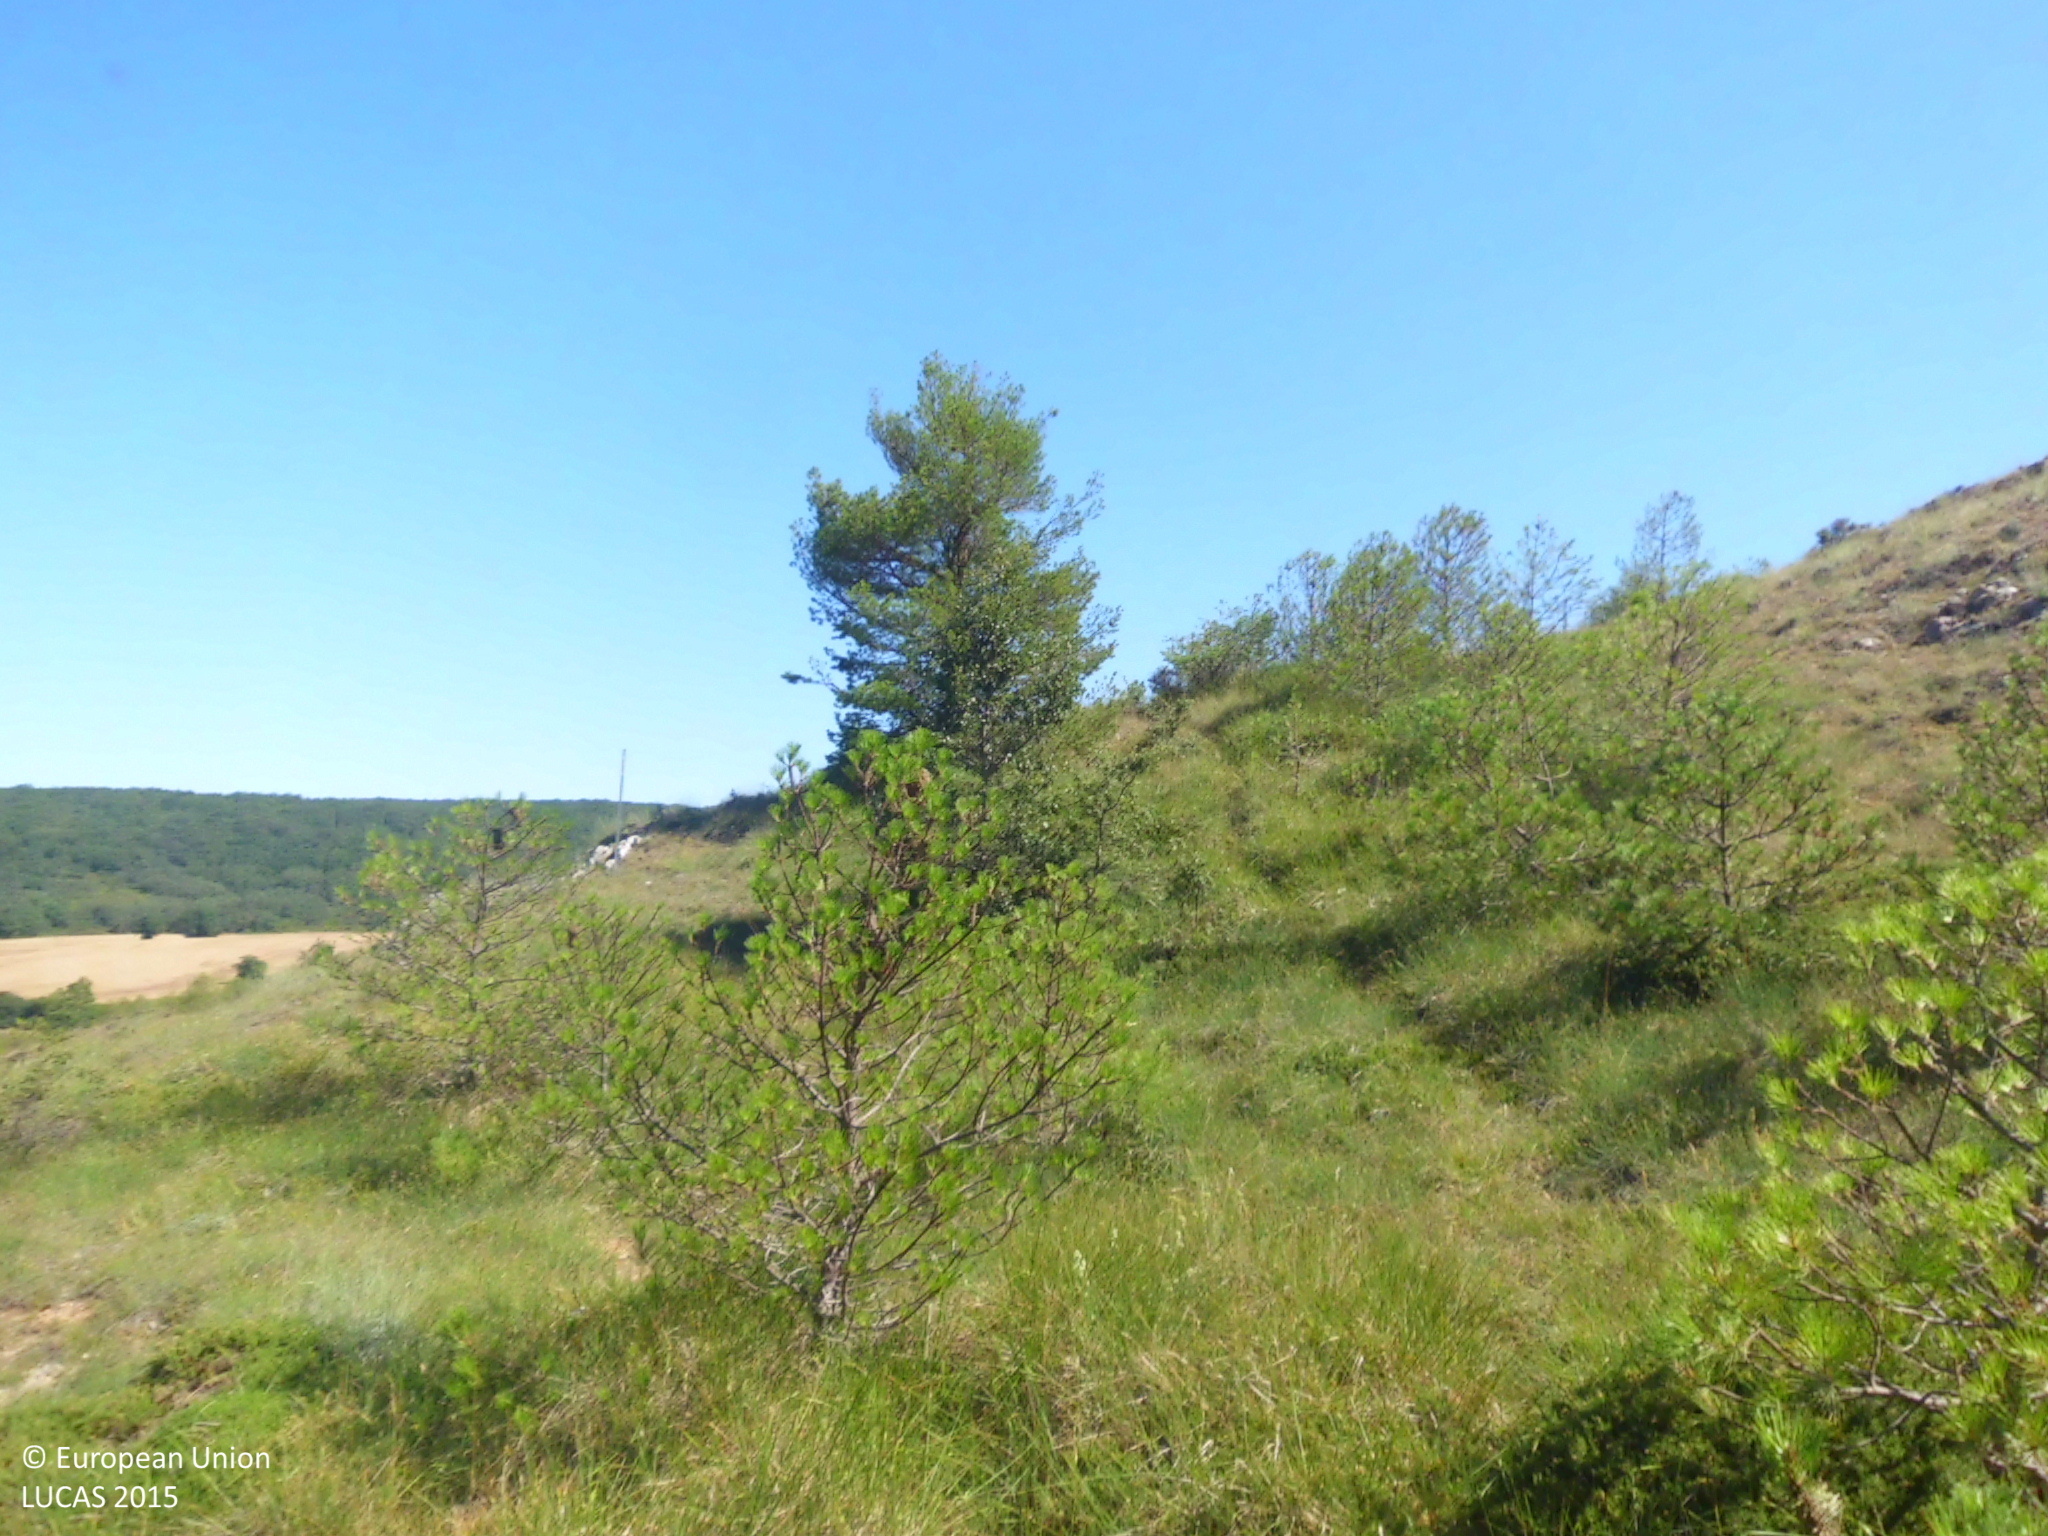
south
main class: Woodland
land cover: Pine dominated coniferous woodland
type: coniferous forest of the mediterranean region
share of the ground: 25 - 50 %
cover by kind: coniferous forest trees 40 %, shrubs 25 %, herbaceous plants 25 %, consolidated bare surface 10 %
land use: Forestry
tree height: < 5 m
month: July
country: ES
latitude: 42.7811
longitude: -4.3405
